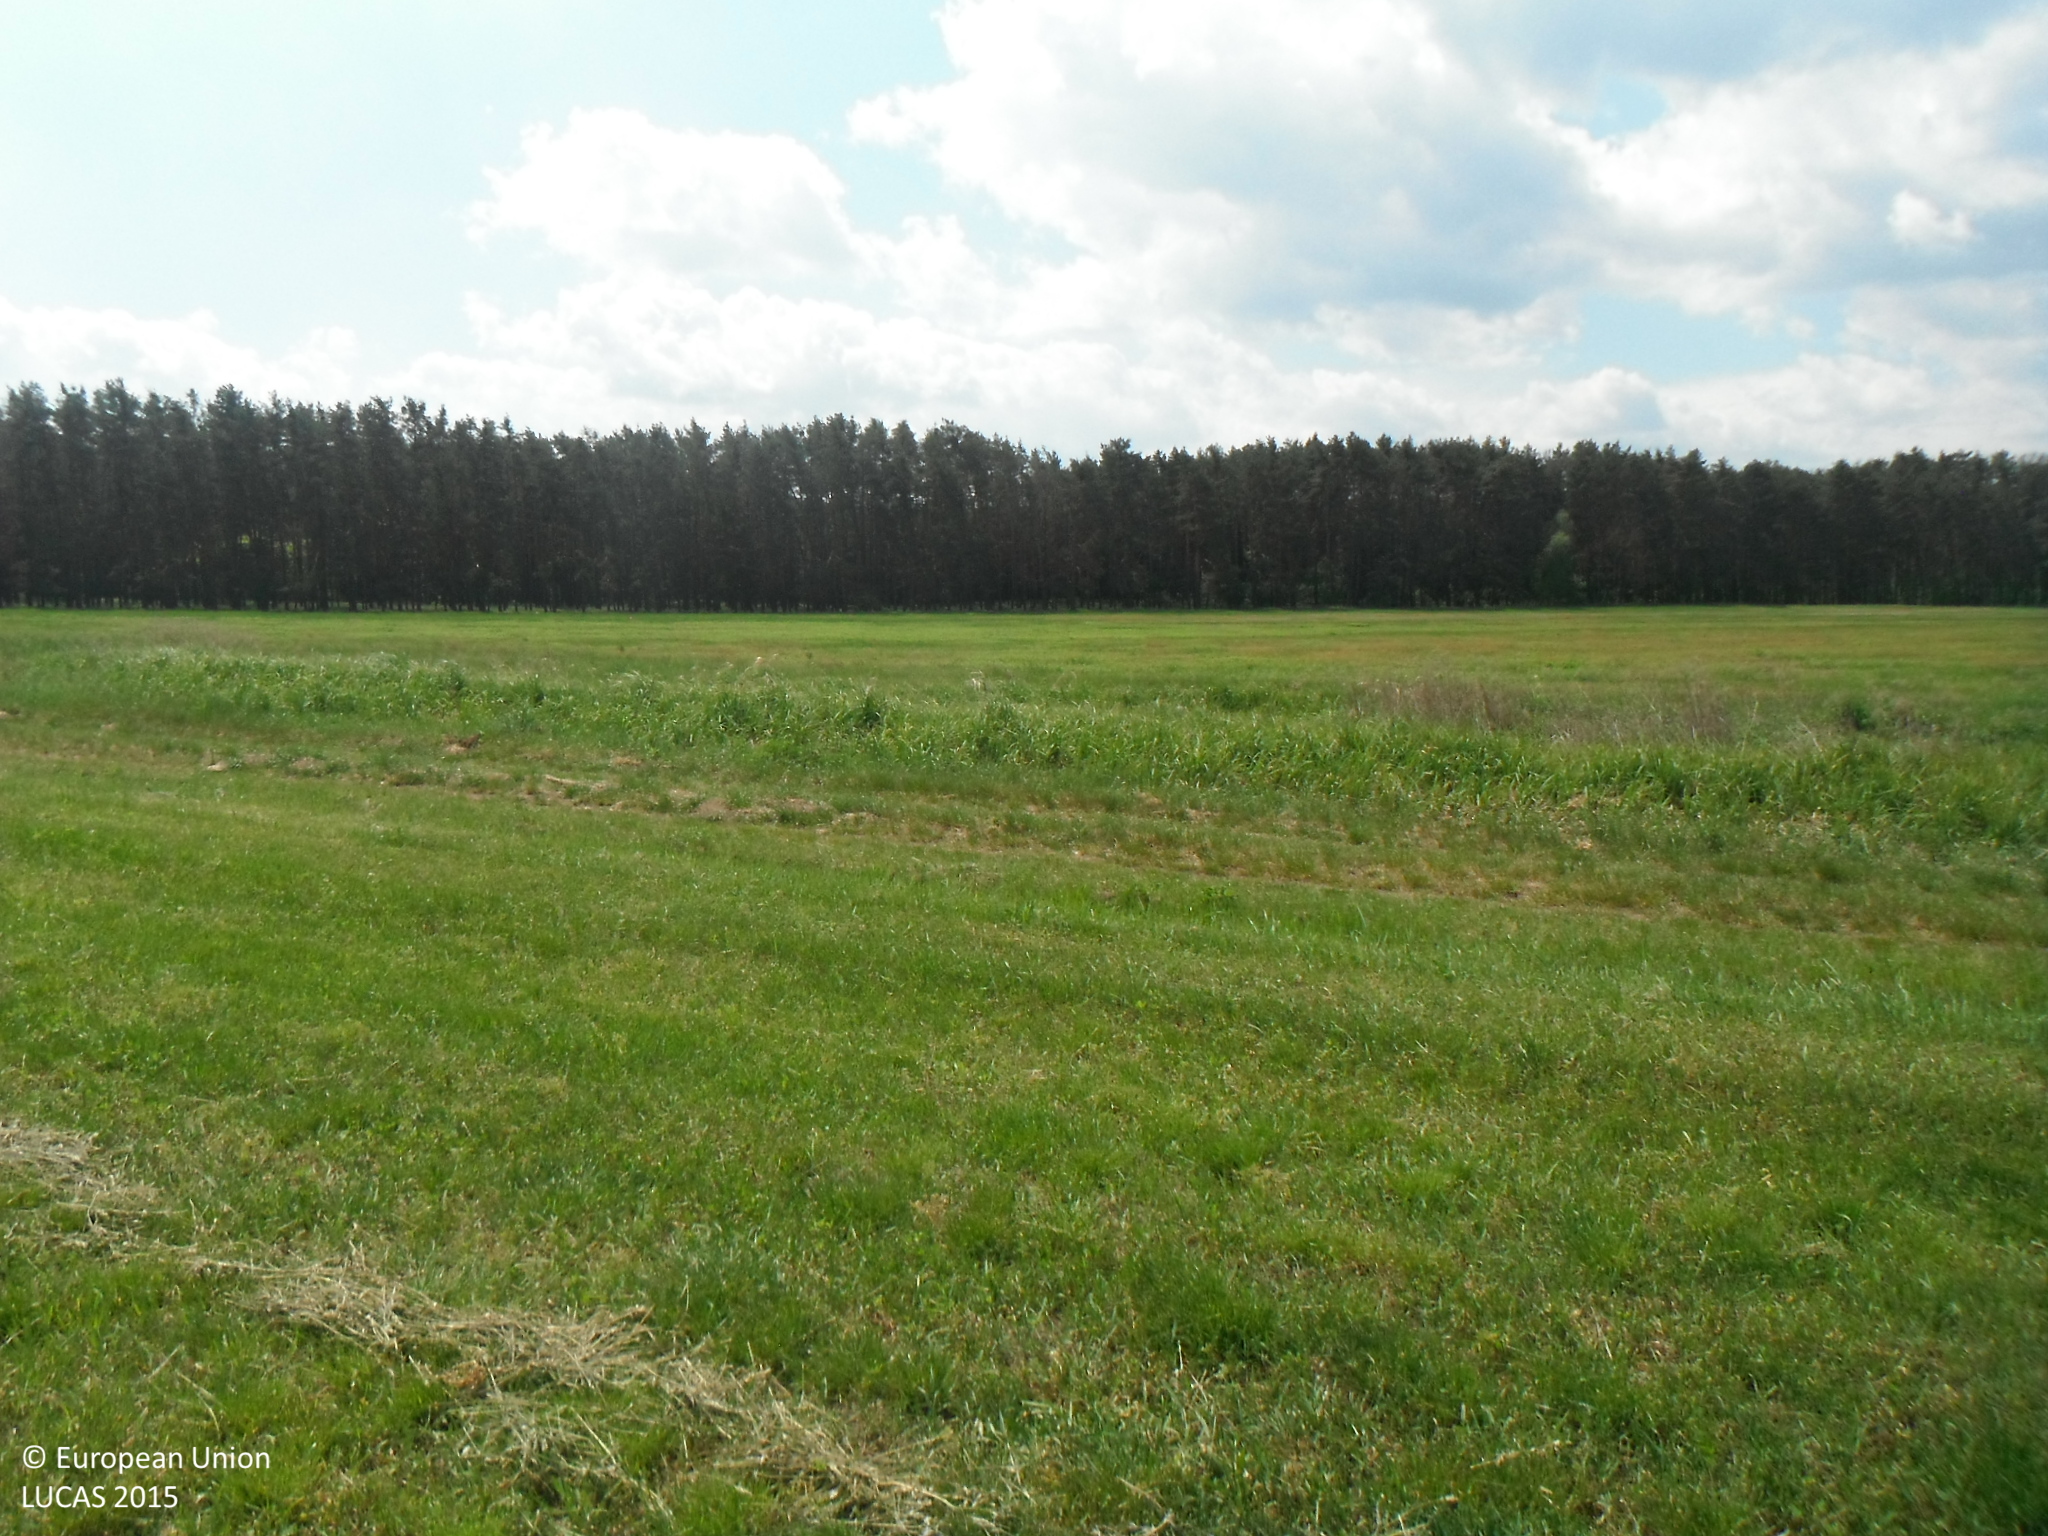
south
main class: Grassland
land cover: Grassland without tree/shrub cover
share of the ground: > 75 %
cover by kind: herbaceous plants 100 %
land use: Agriculture (excluding fallow land and kitchen gardens)
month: May
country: SK
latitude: 48.5582
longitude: 17.0405
